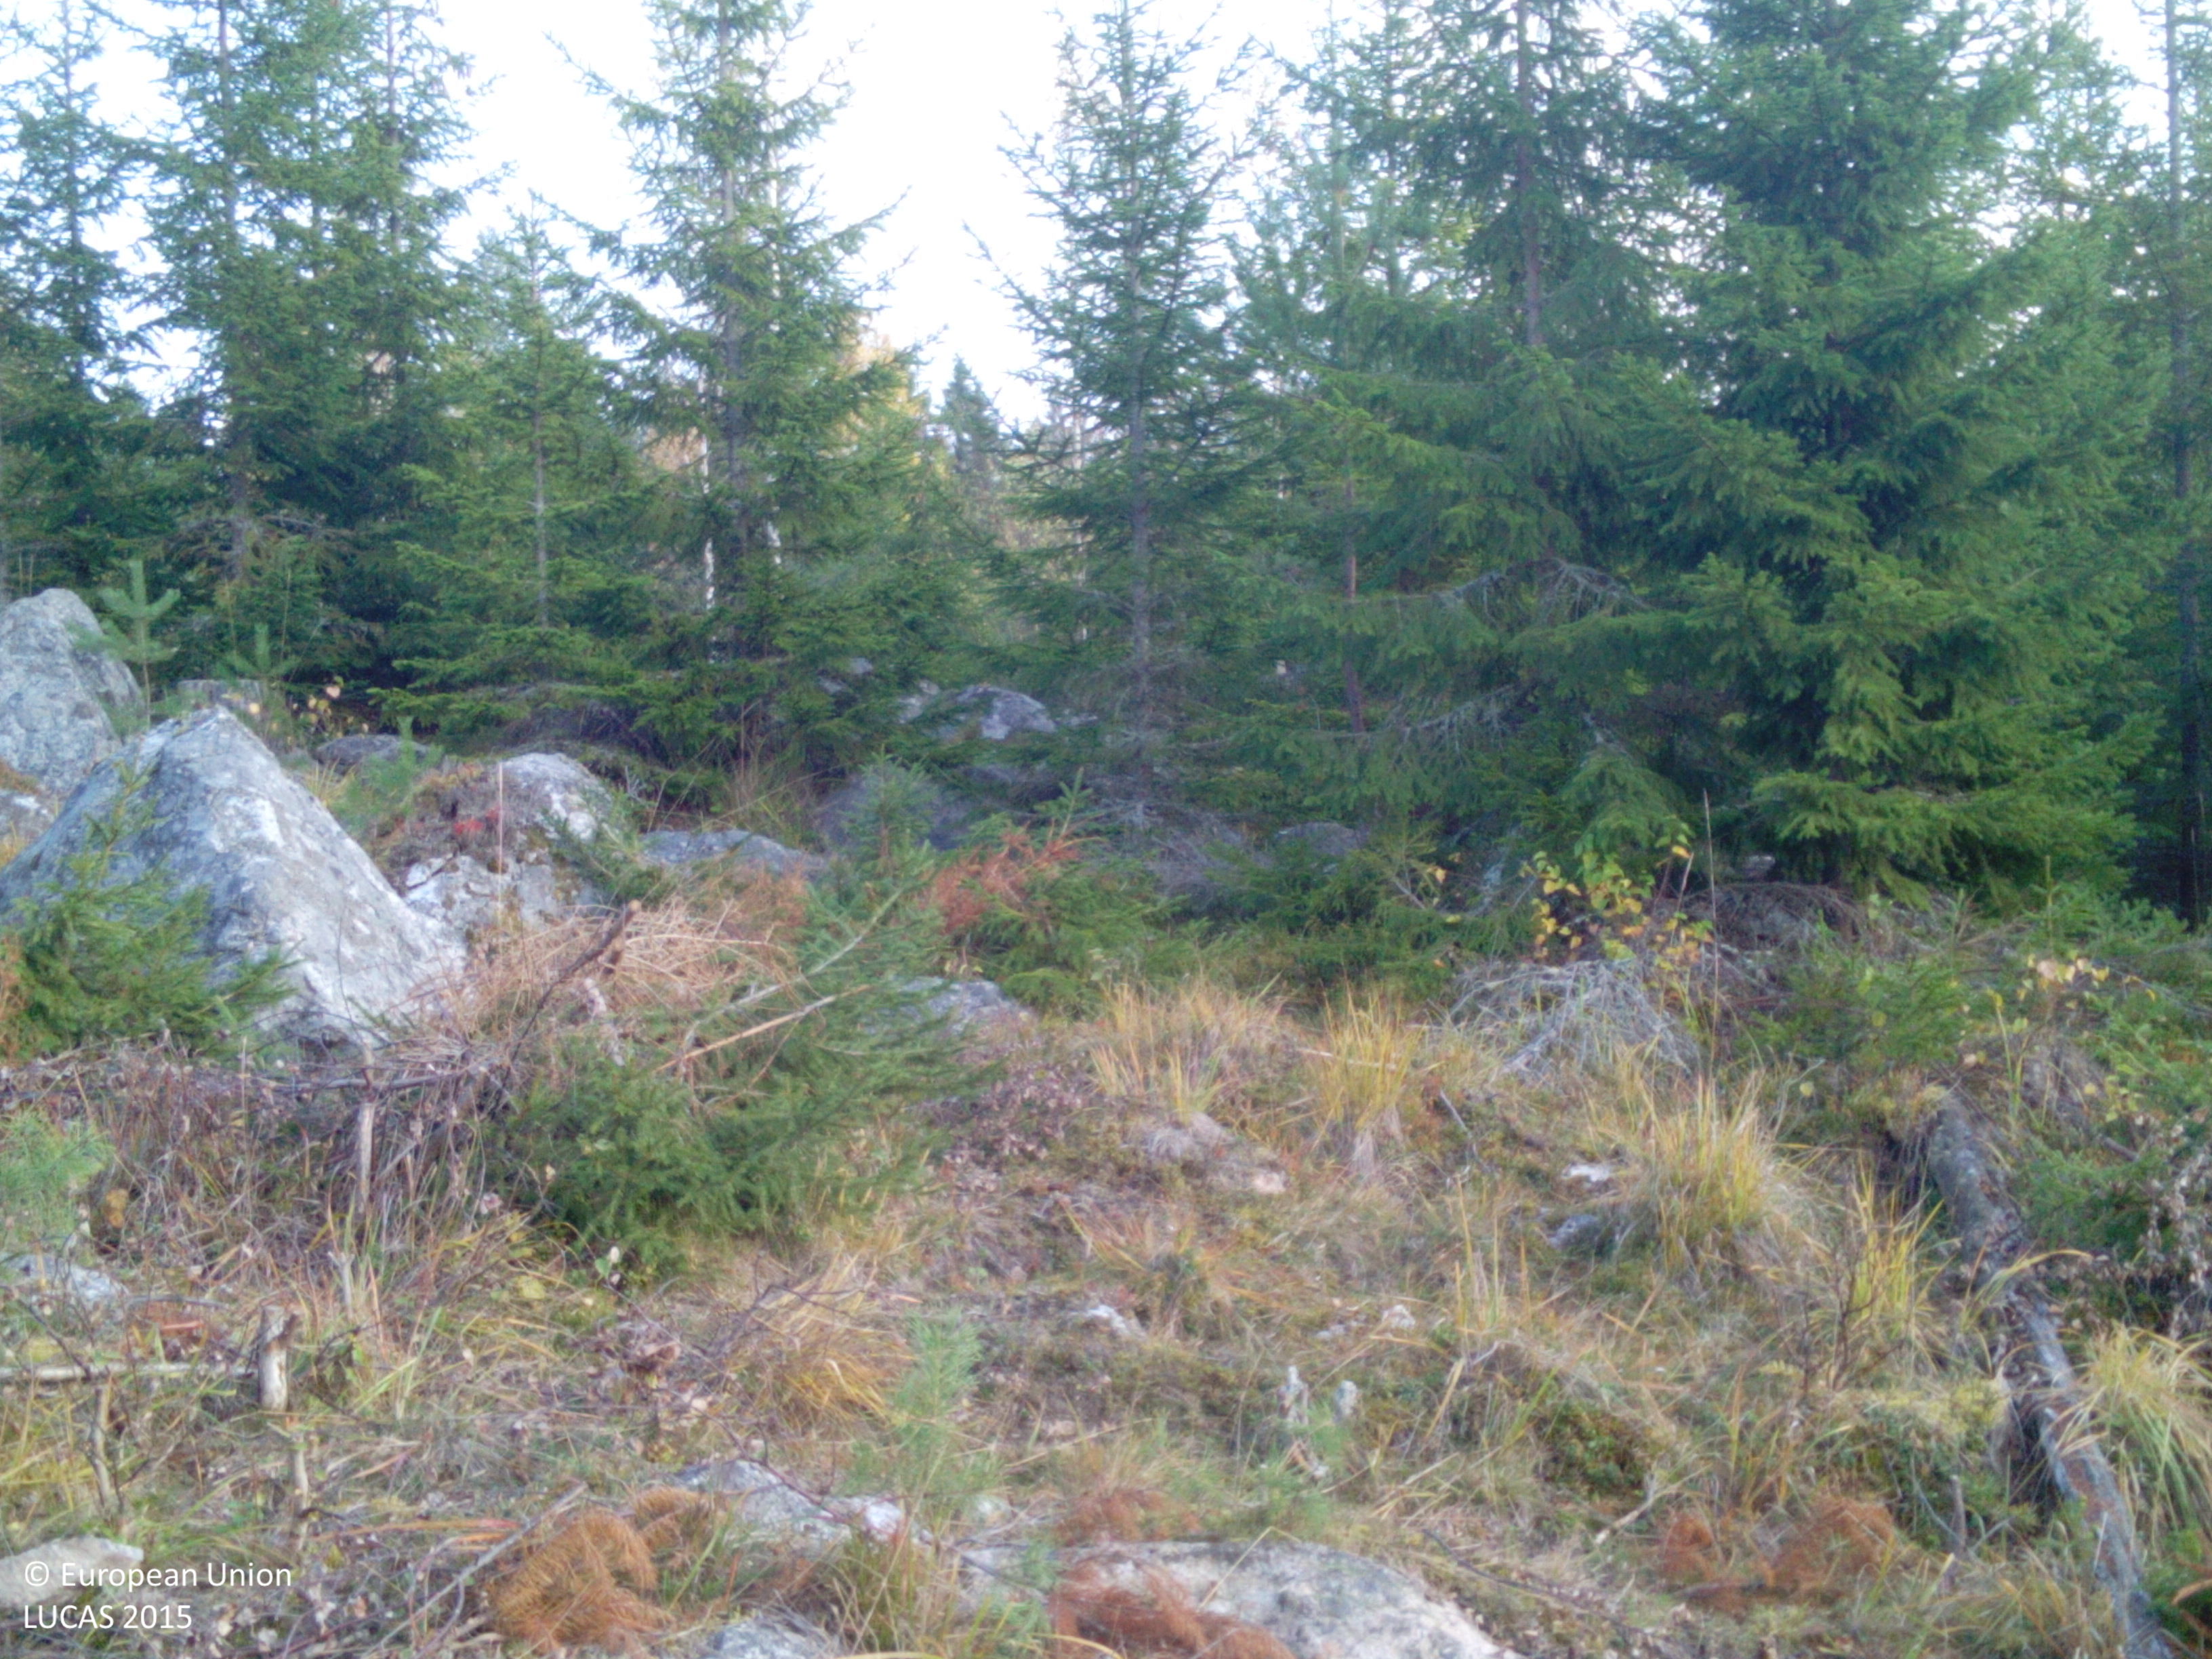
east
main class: Woodland
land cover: Spruce dominated mixed woodland
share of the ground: 50 - 75 %
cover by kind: herbaceous plants 45 %, coniferous forest trees 25 %, broadleaved forest trees 25 %, lichens and mosses 5 %
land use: Forestry
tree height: < 5 m
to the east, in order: Spruce dominated mixed woodland; Electric lines; Spruce dominated mixed woodland; Spruce dominated coniferous woodland
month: October
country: SE
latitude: 58.8845
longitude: 16.2921
